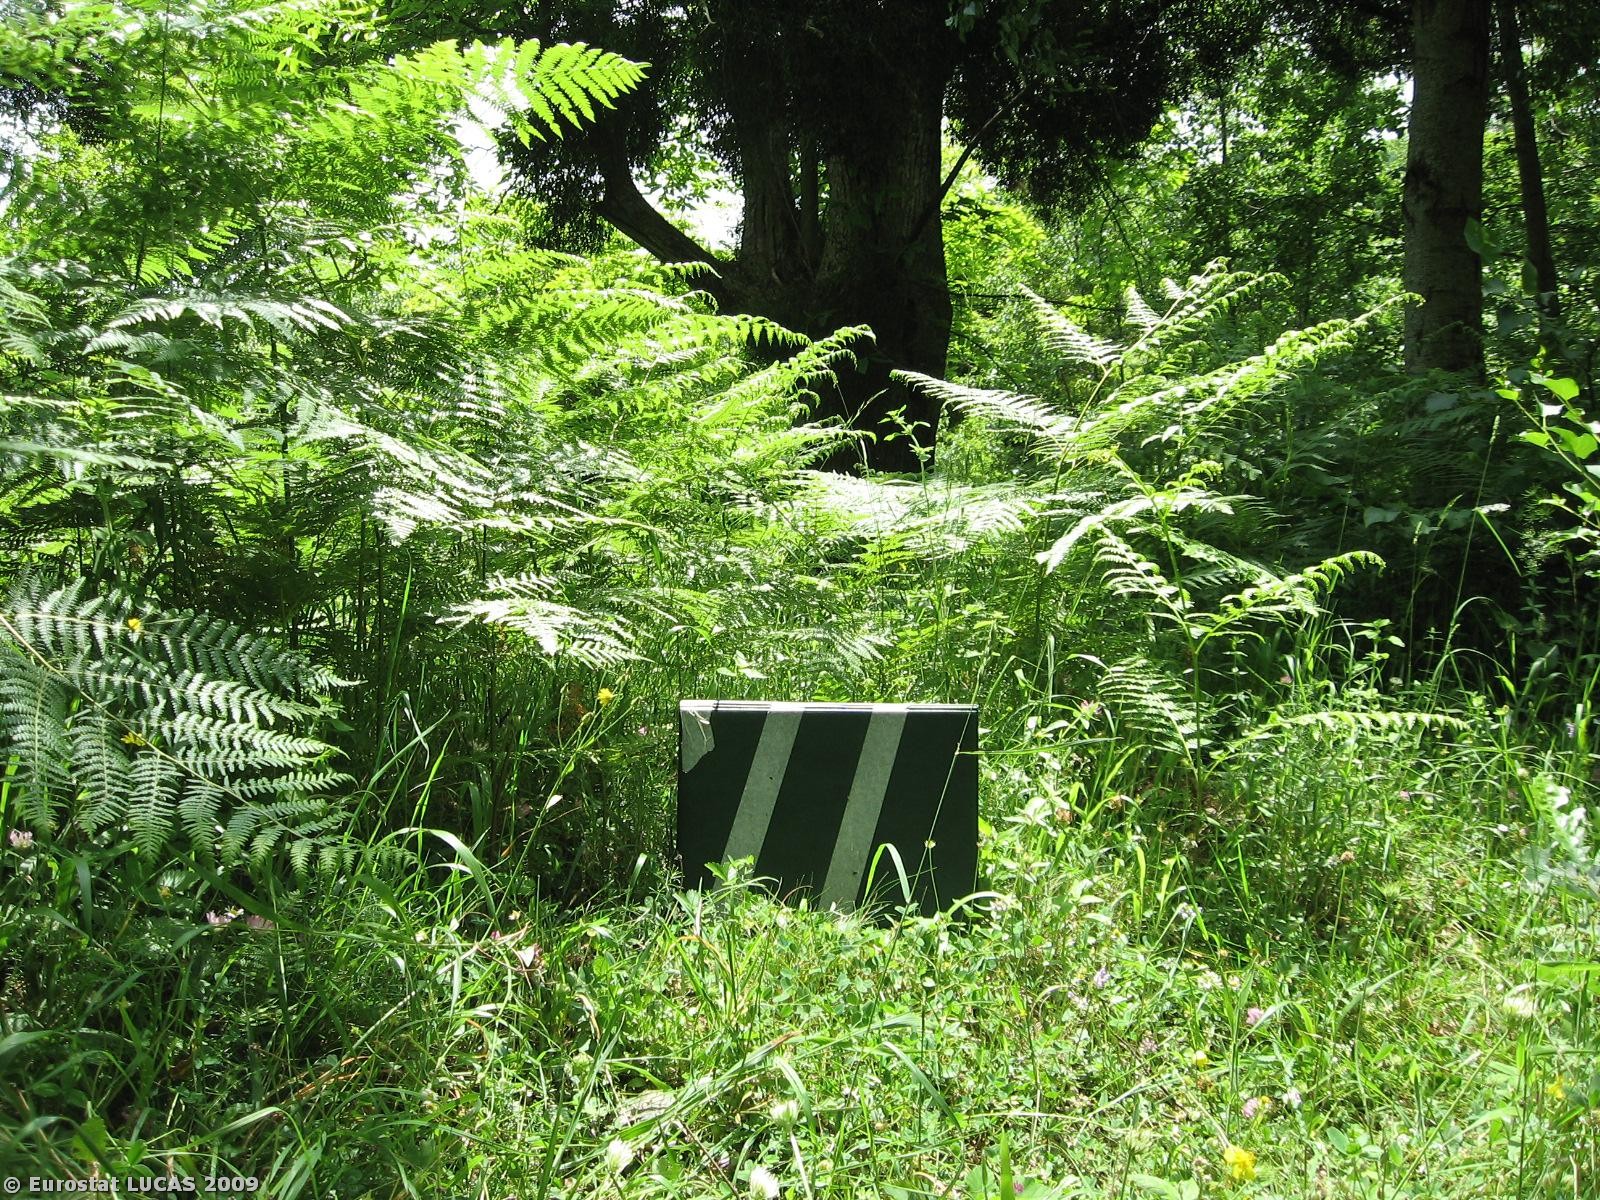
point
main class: Woodland
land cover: Broadleaved woodland
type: thermophilous deciduous forest
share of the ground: > 75 %
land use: Agriculture (excluding fallow land and kitchen gardens)
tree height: > 5 m
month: June
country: IT
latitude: 38.9853
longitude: 16.4202
